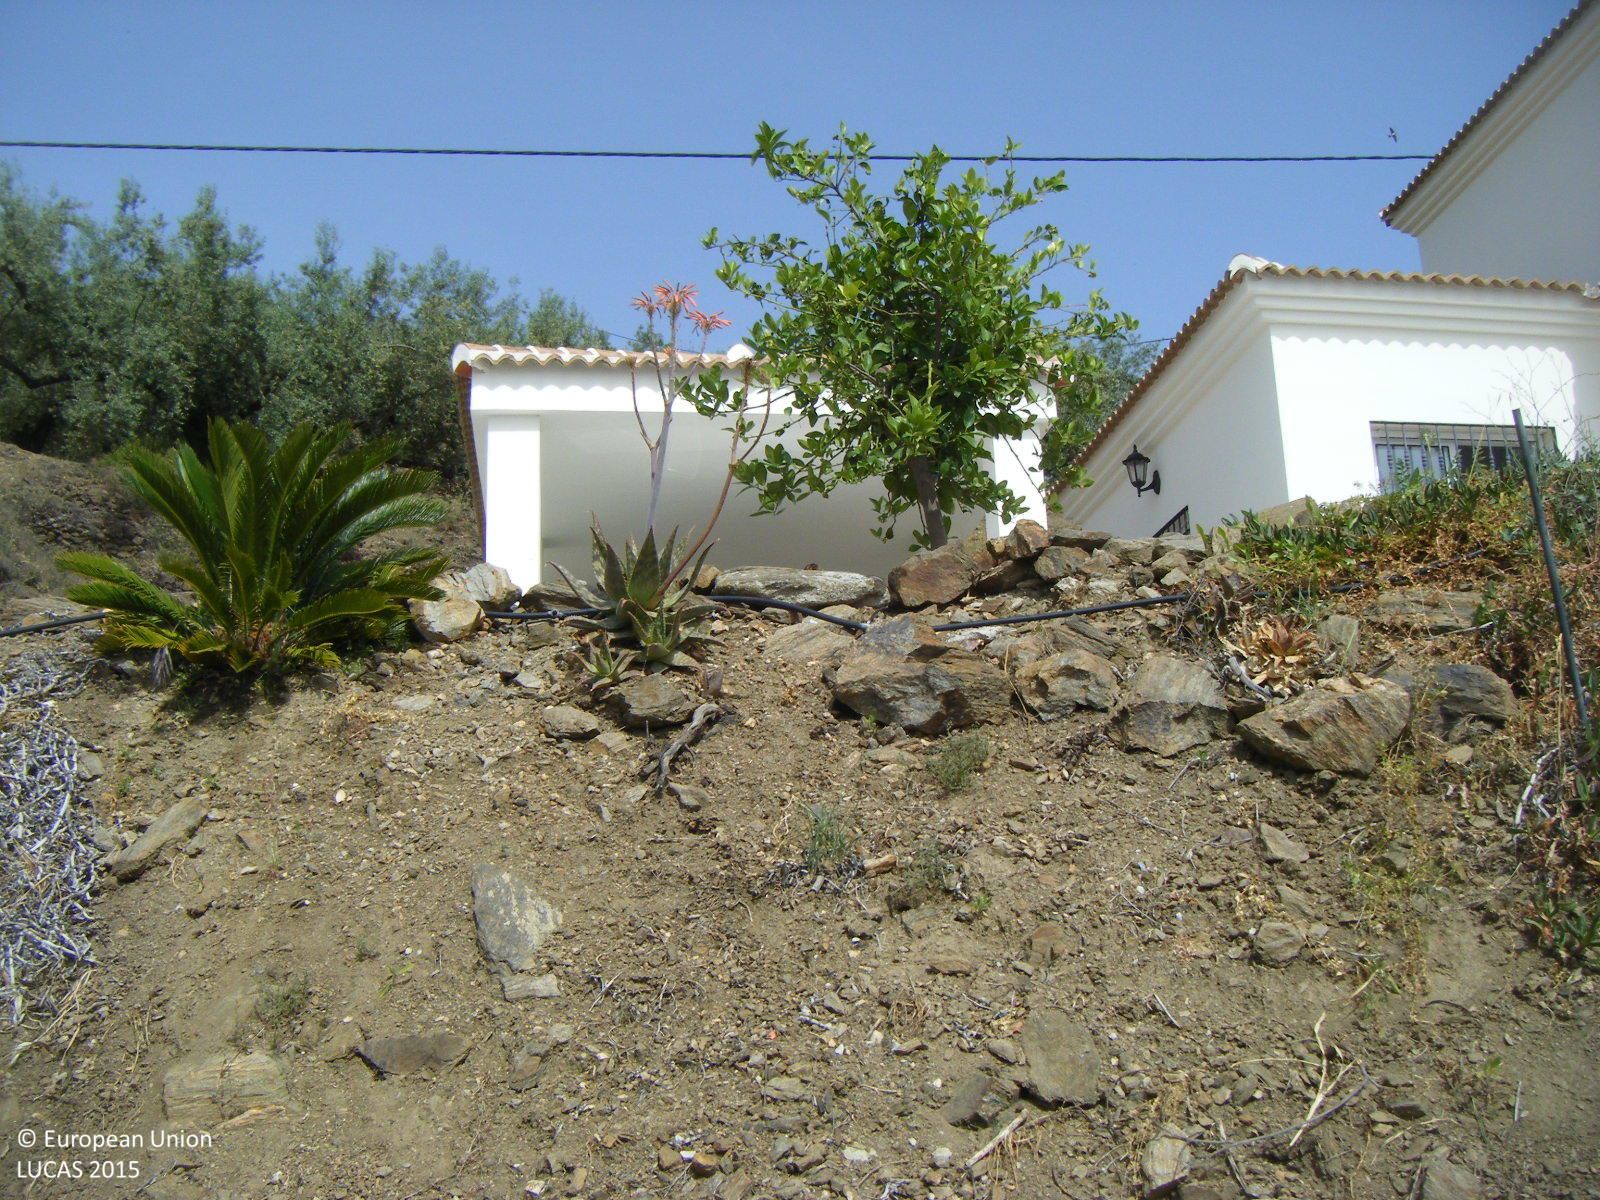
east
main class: Grassland
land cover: Grassland without tree/shrub cover
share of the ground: > 75 %
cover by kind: herbaceous plants 100 %
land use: Semi-natural and natural areas not in use
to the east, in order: Grassland without tree/shrub cover; Artificial constructions in urban areas; Electric lines; Tracks; Olive groves; Artificial constructions in urban areas; Olive groves; Tracks; Artificial constructions in urban areas; Permanent crops (only in case pi)
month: May
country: ES
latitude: 36.8084
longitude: -4.0547
